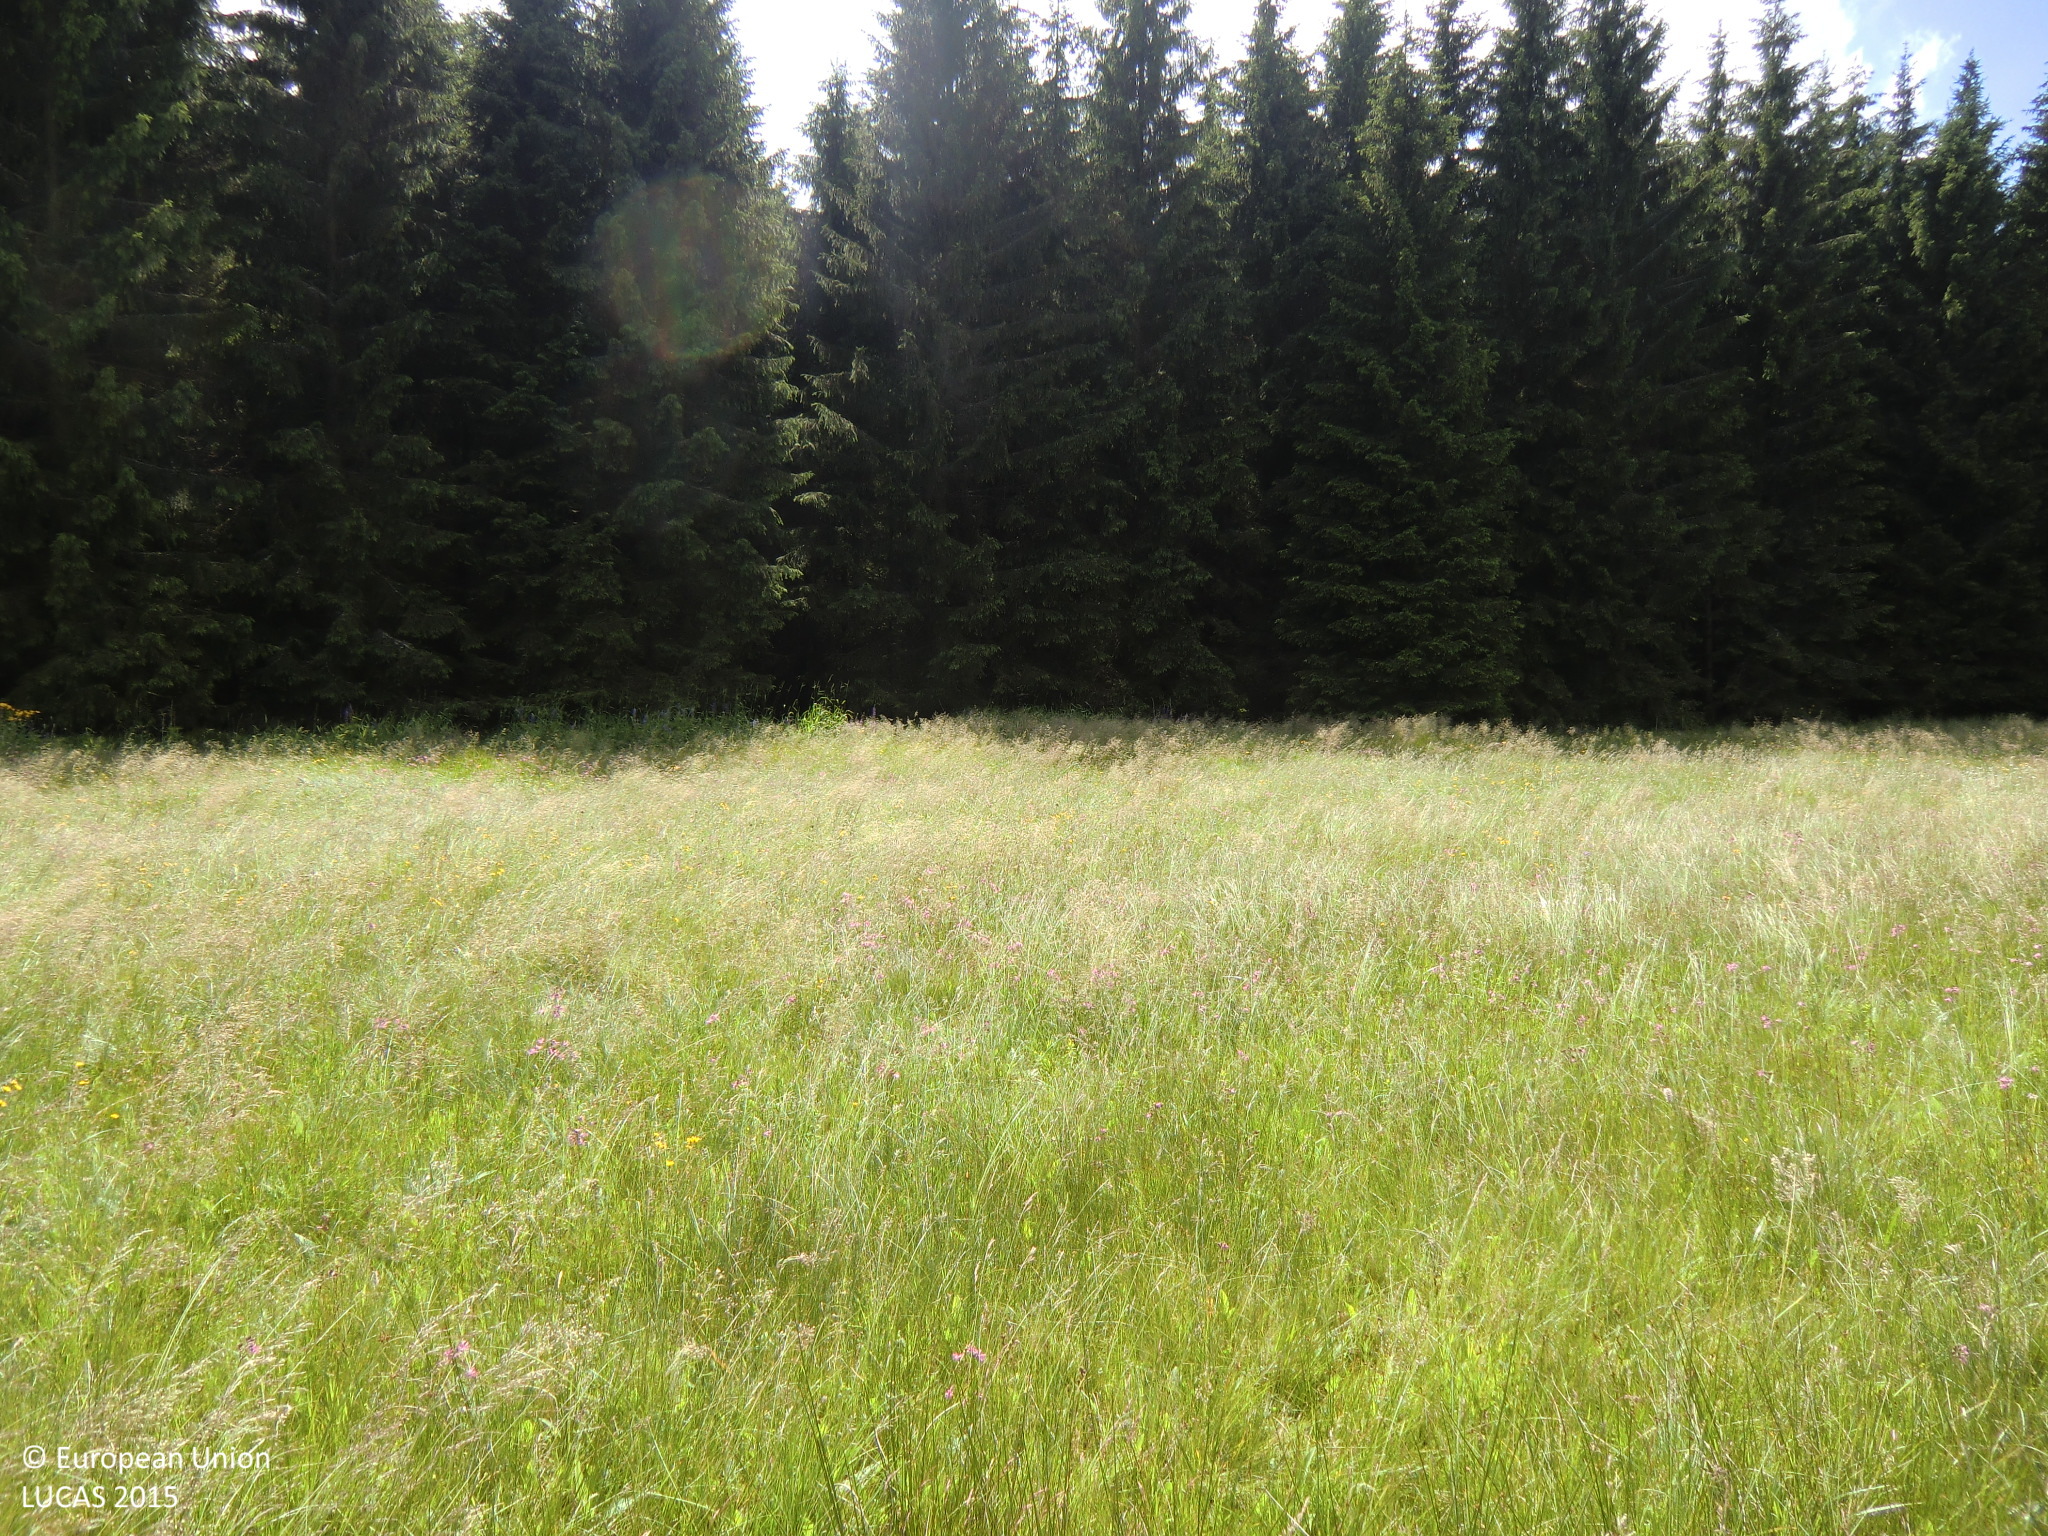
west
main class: Grassland
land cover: Grassland without tree/shrub cover
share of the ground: > 75 %
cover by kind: herbaceous plants 100 %
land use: Agriculture (excluding fallow land and kitchen gardens)
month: June
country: AT
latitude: 48.5199
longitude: 14.6991
